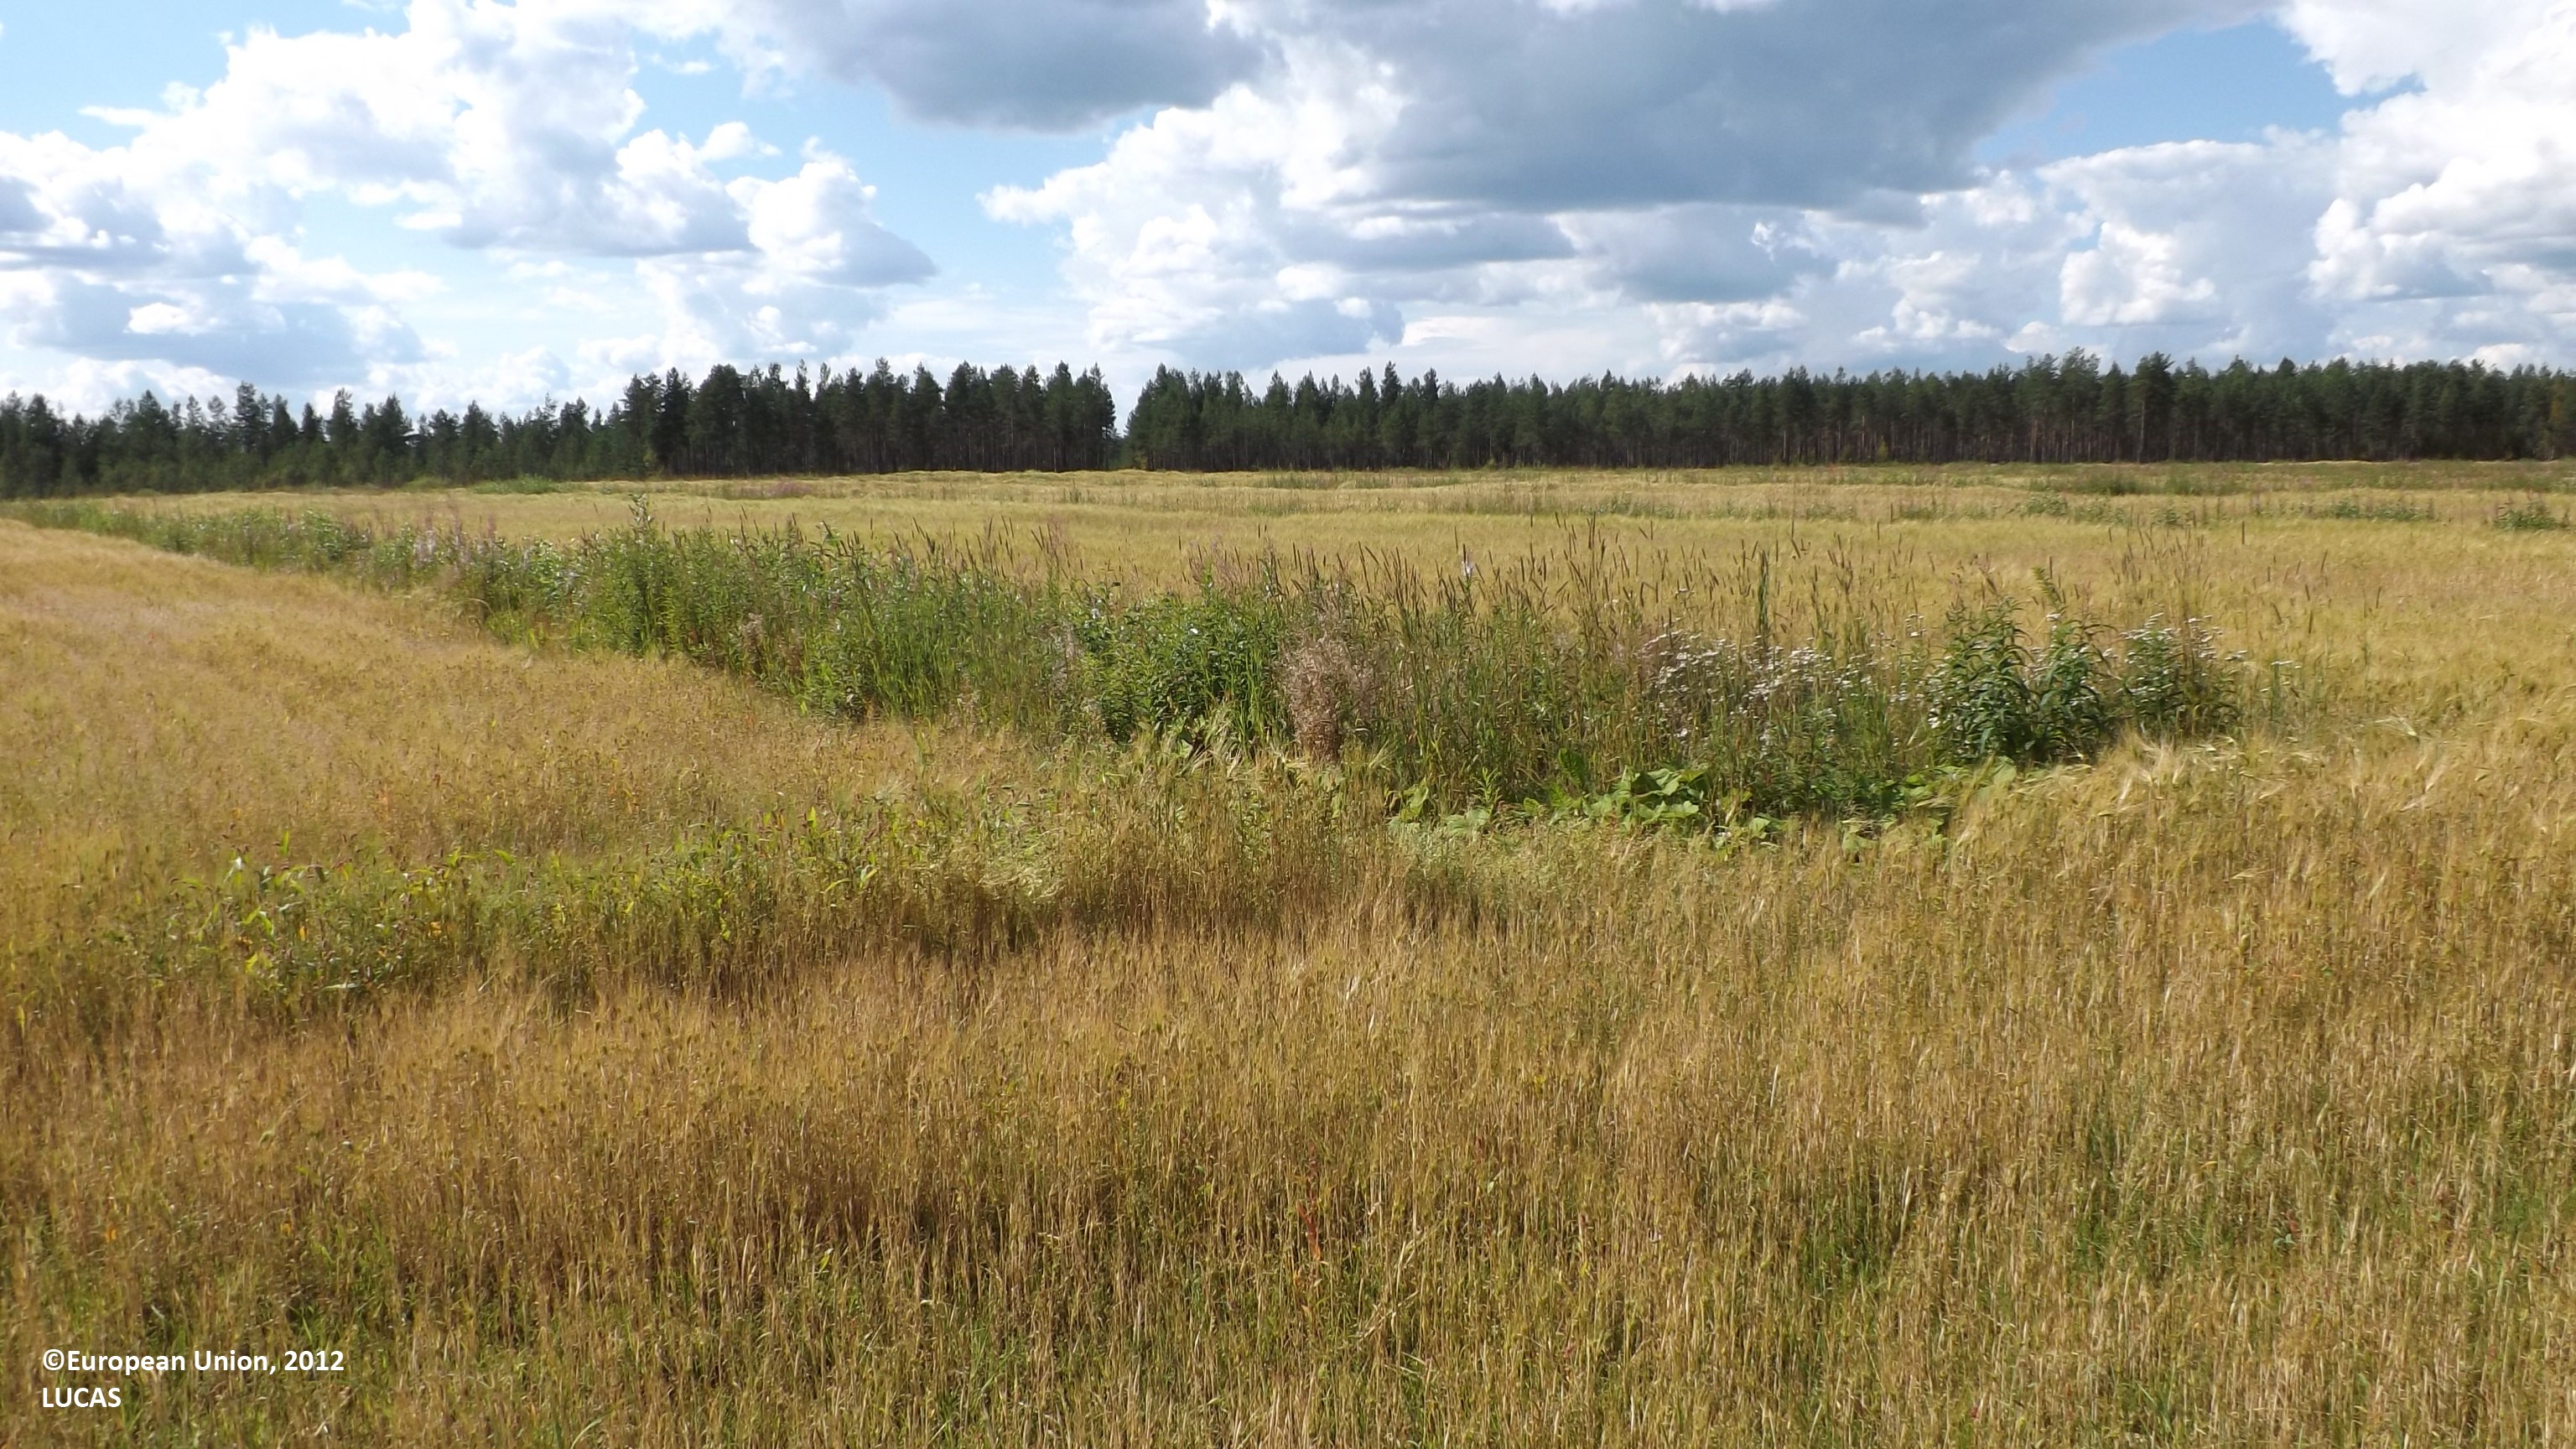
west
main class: Cropland
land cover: Barley
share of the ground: > 75 %
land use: Agriculture (excluding fallow land and kitchen gardens)
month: August
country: FI
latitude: 63.2050
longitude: 24.3764
